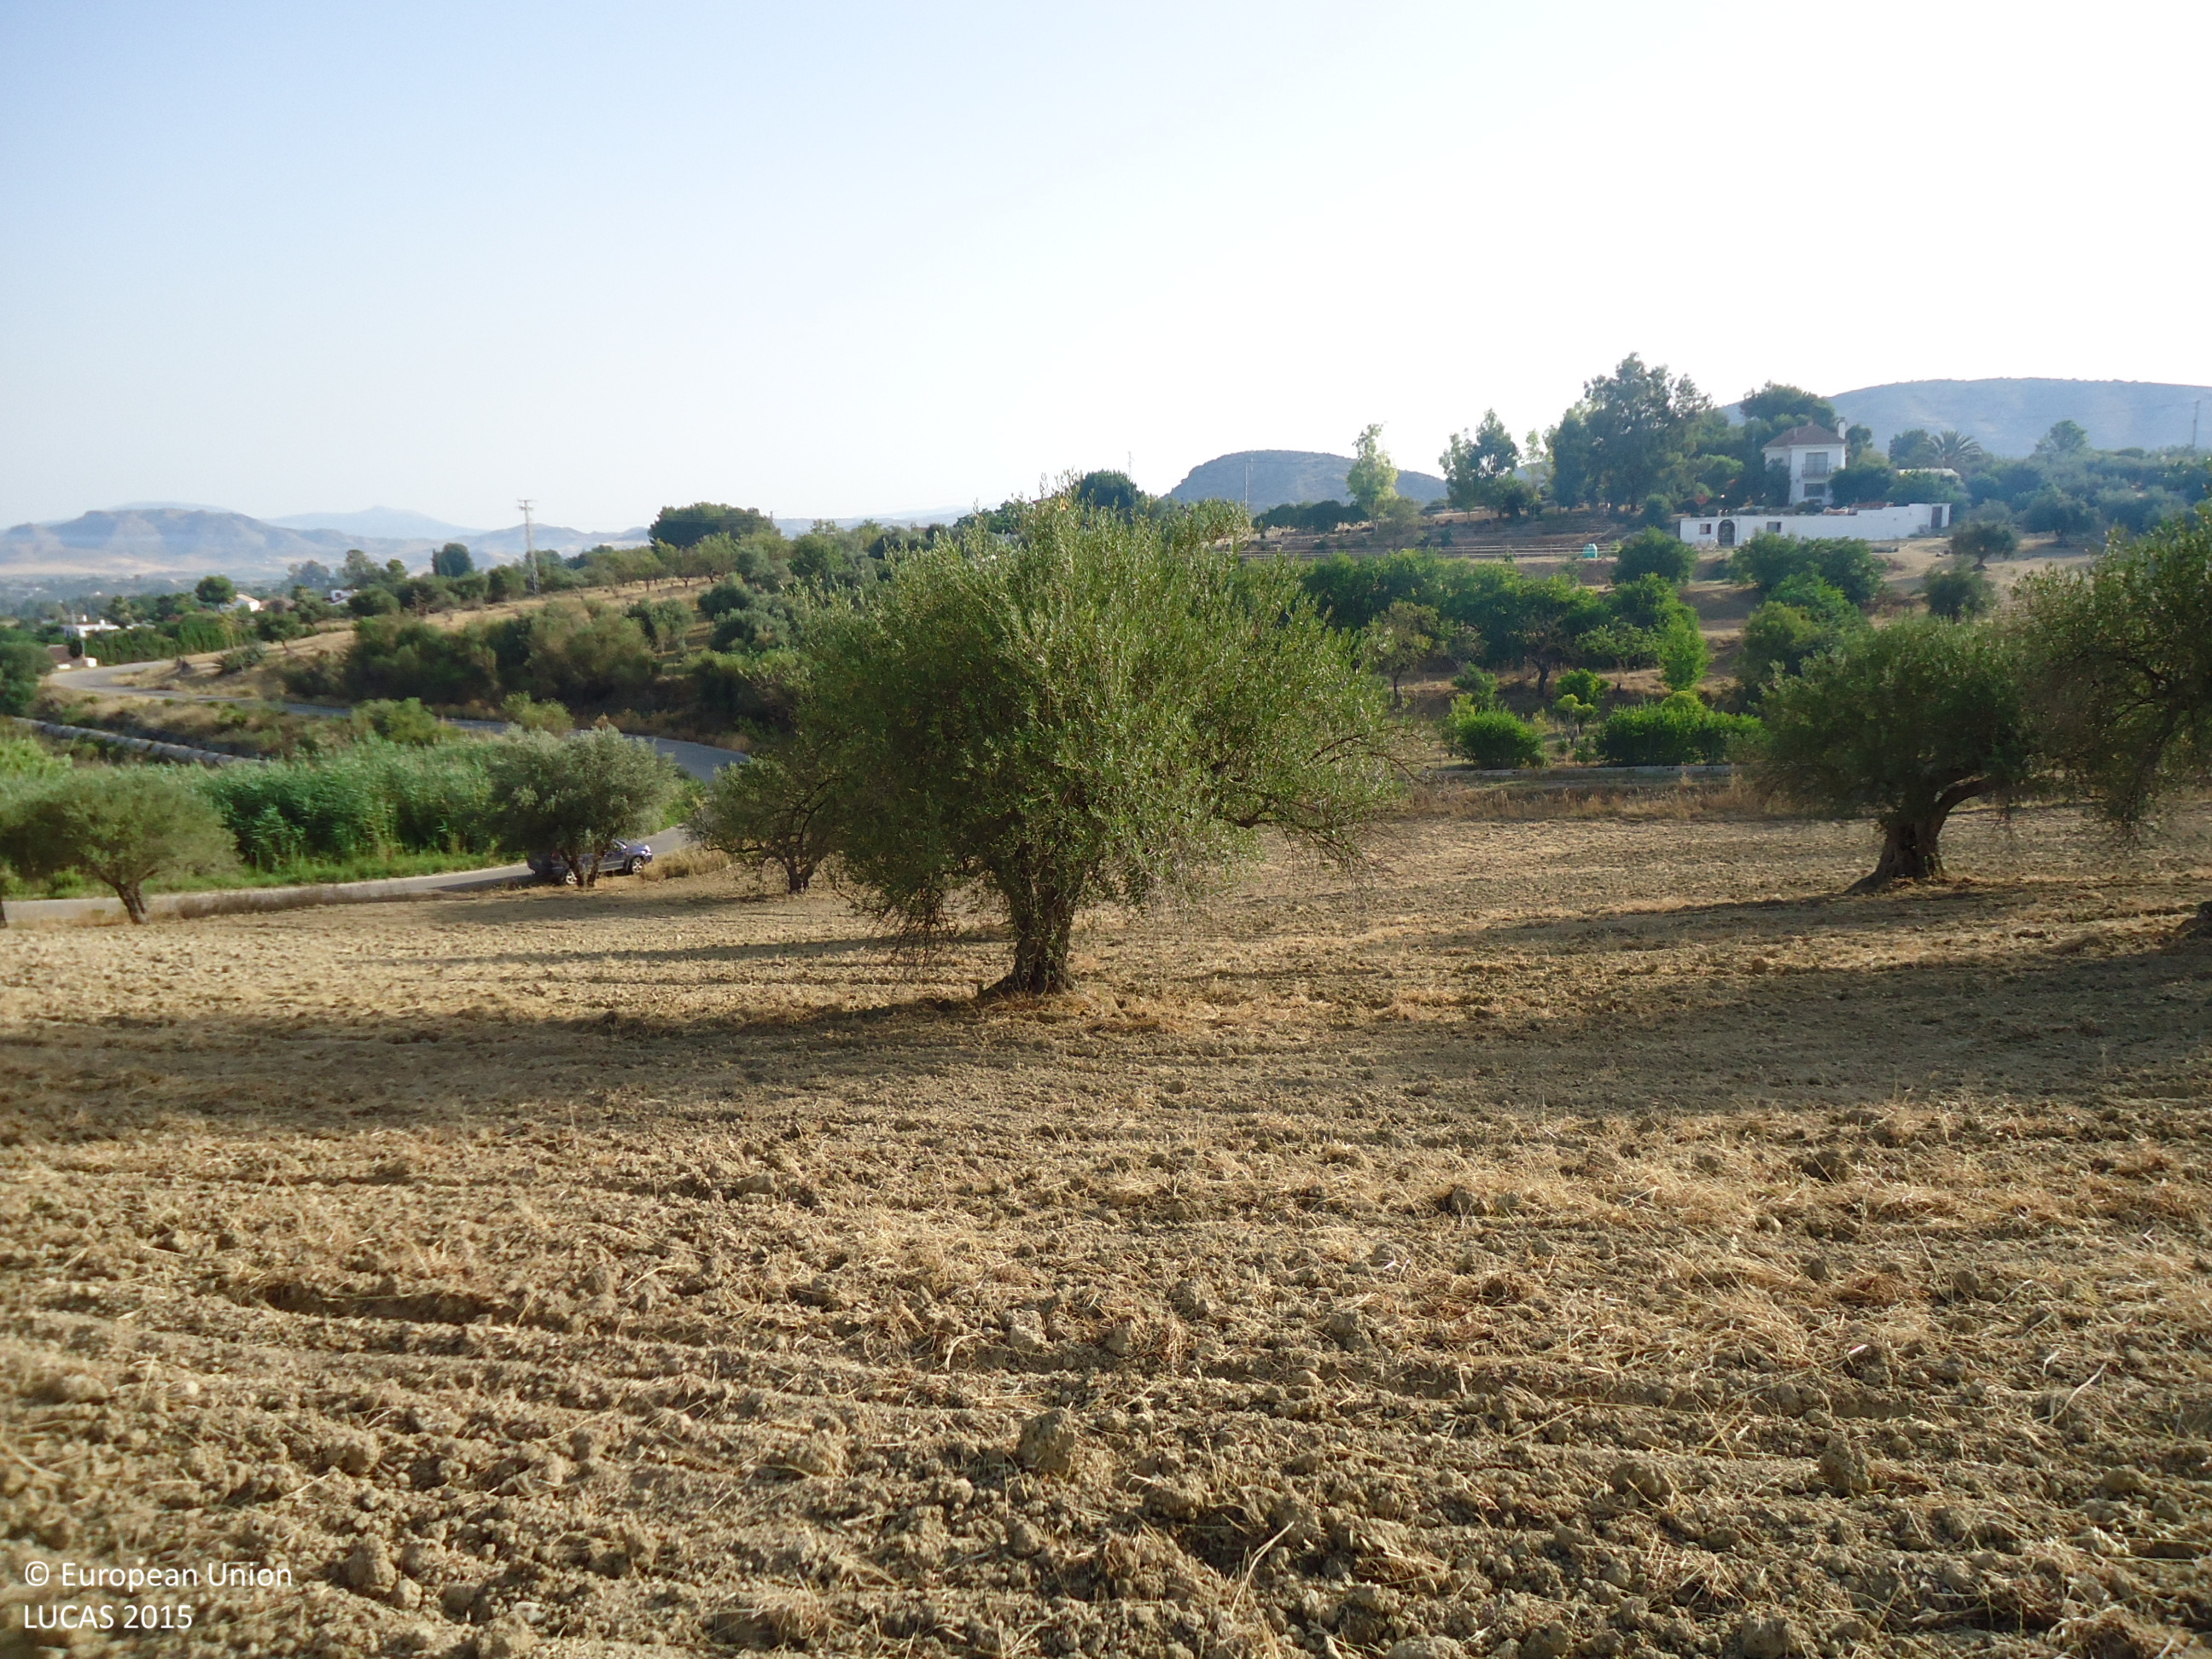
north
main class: Cropland
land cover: Olive groves
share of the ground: 10 - 25 %
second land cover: Other bare soil
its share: > 75 %
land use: Agriculture (excluding fallow land and kitchen gardens)
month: June
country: ES
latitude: 36.6780
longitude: -4.6619
